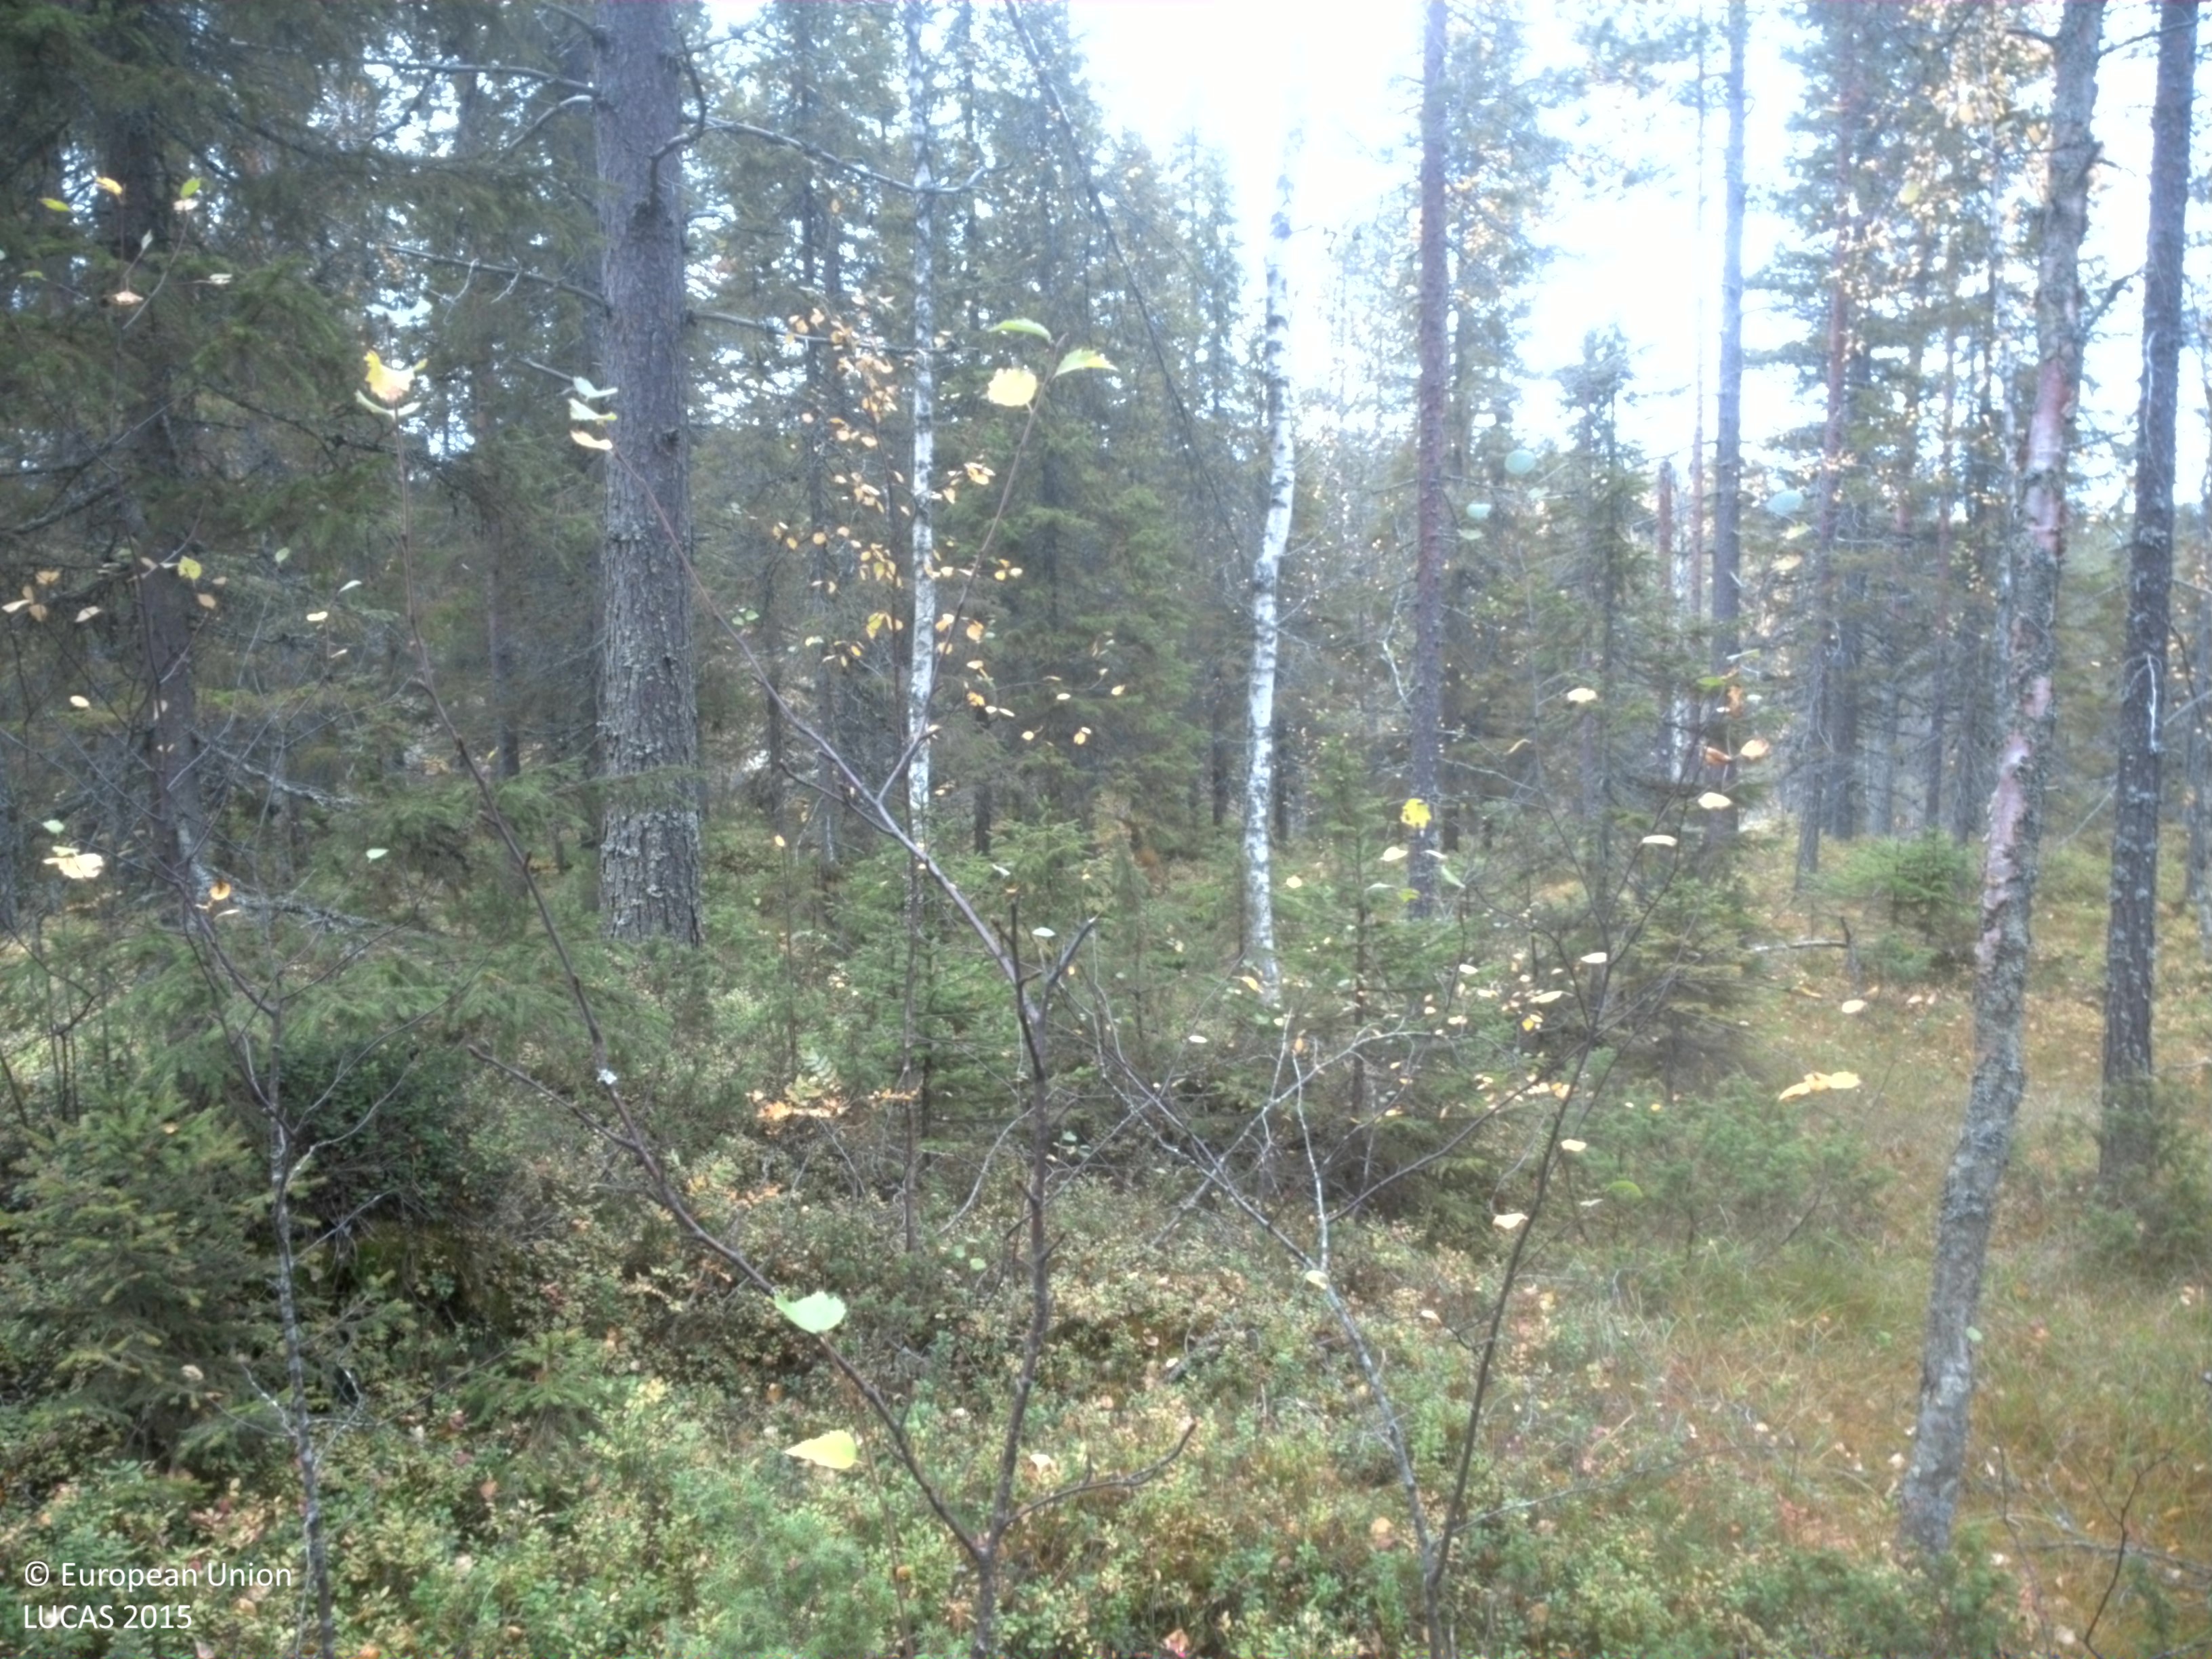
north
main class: Woodland
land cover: Pine dominated coniferous woodland
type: boreal forest
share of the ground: 50 - 75 %
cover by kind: coniferous forest trees 50 %, shrubs 25 %, herbaceous plants 10 %, lichens and mosses 10 %, broadleaved forest trees 5 %
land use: Forestry
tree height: > 5 m
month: September
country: SE
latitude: 64.3055
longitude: 20.2096
